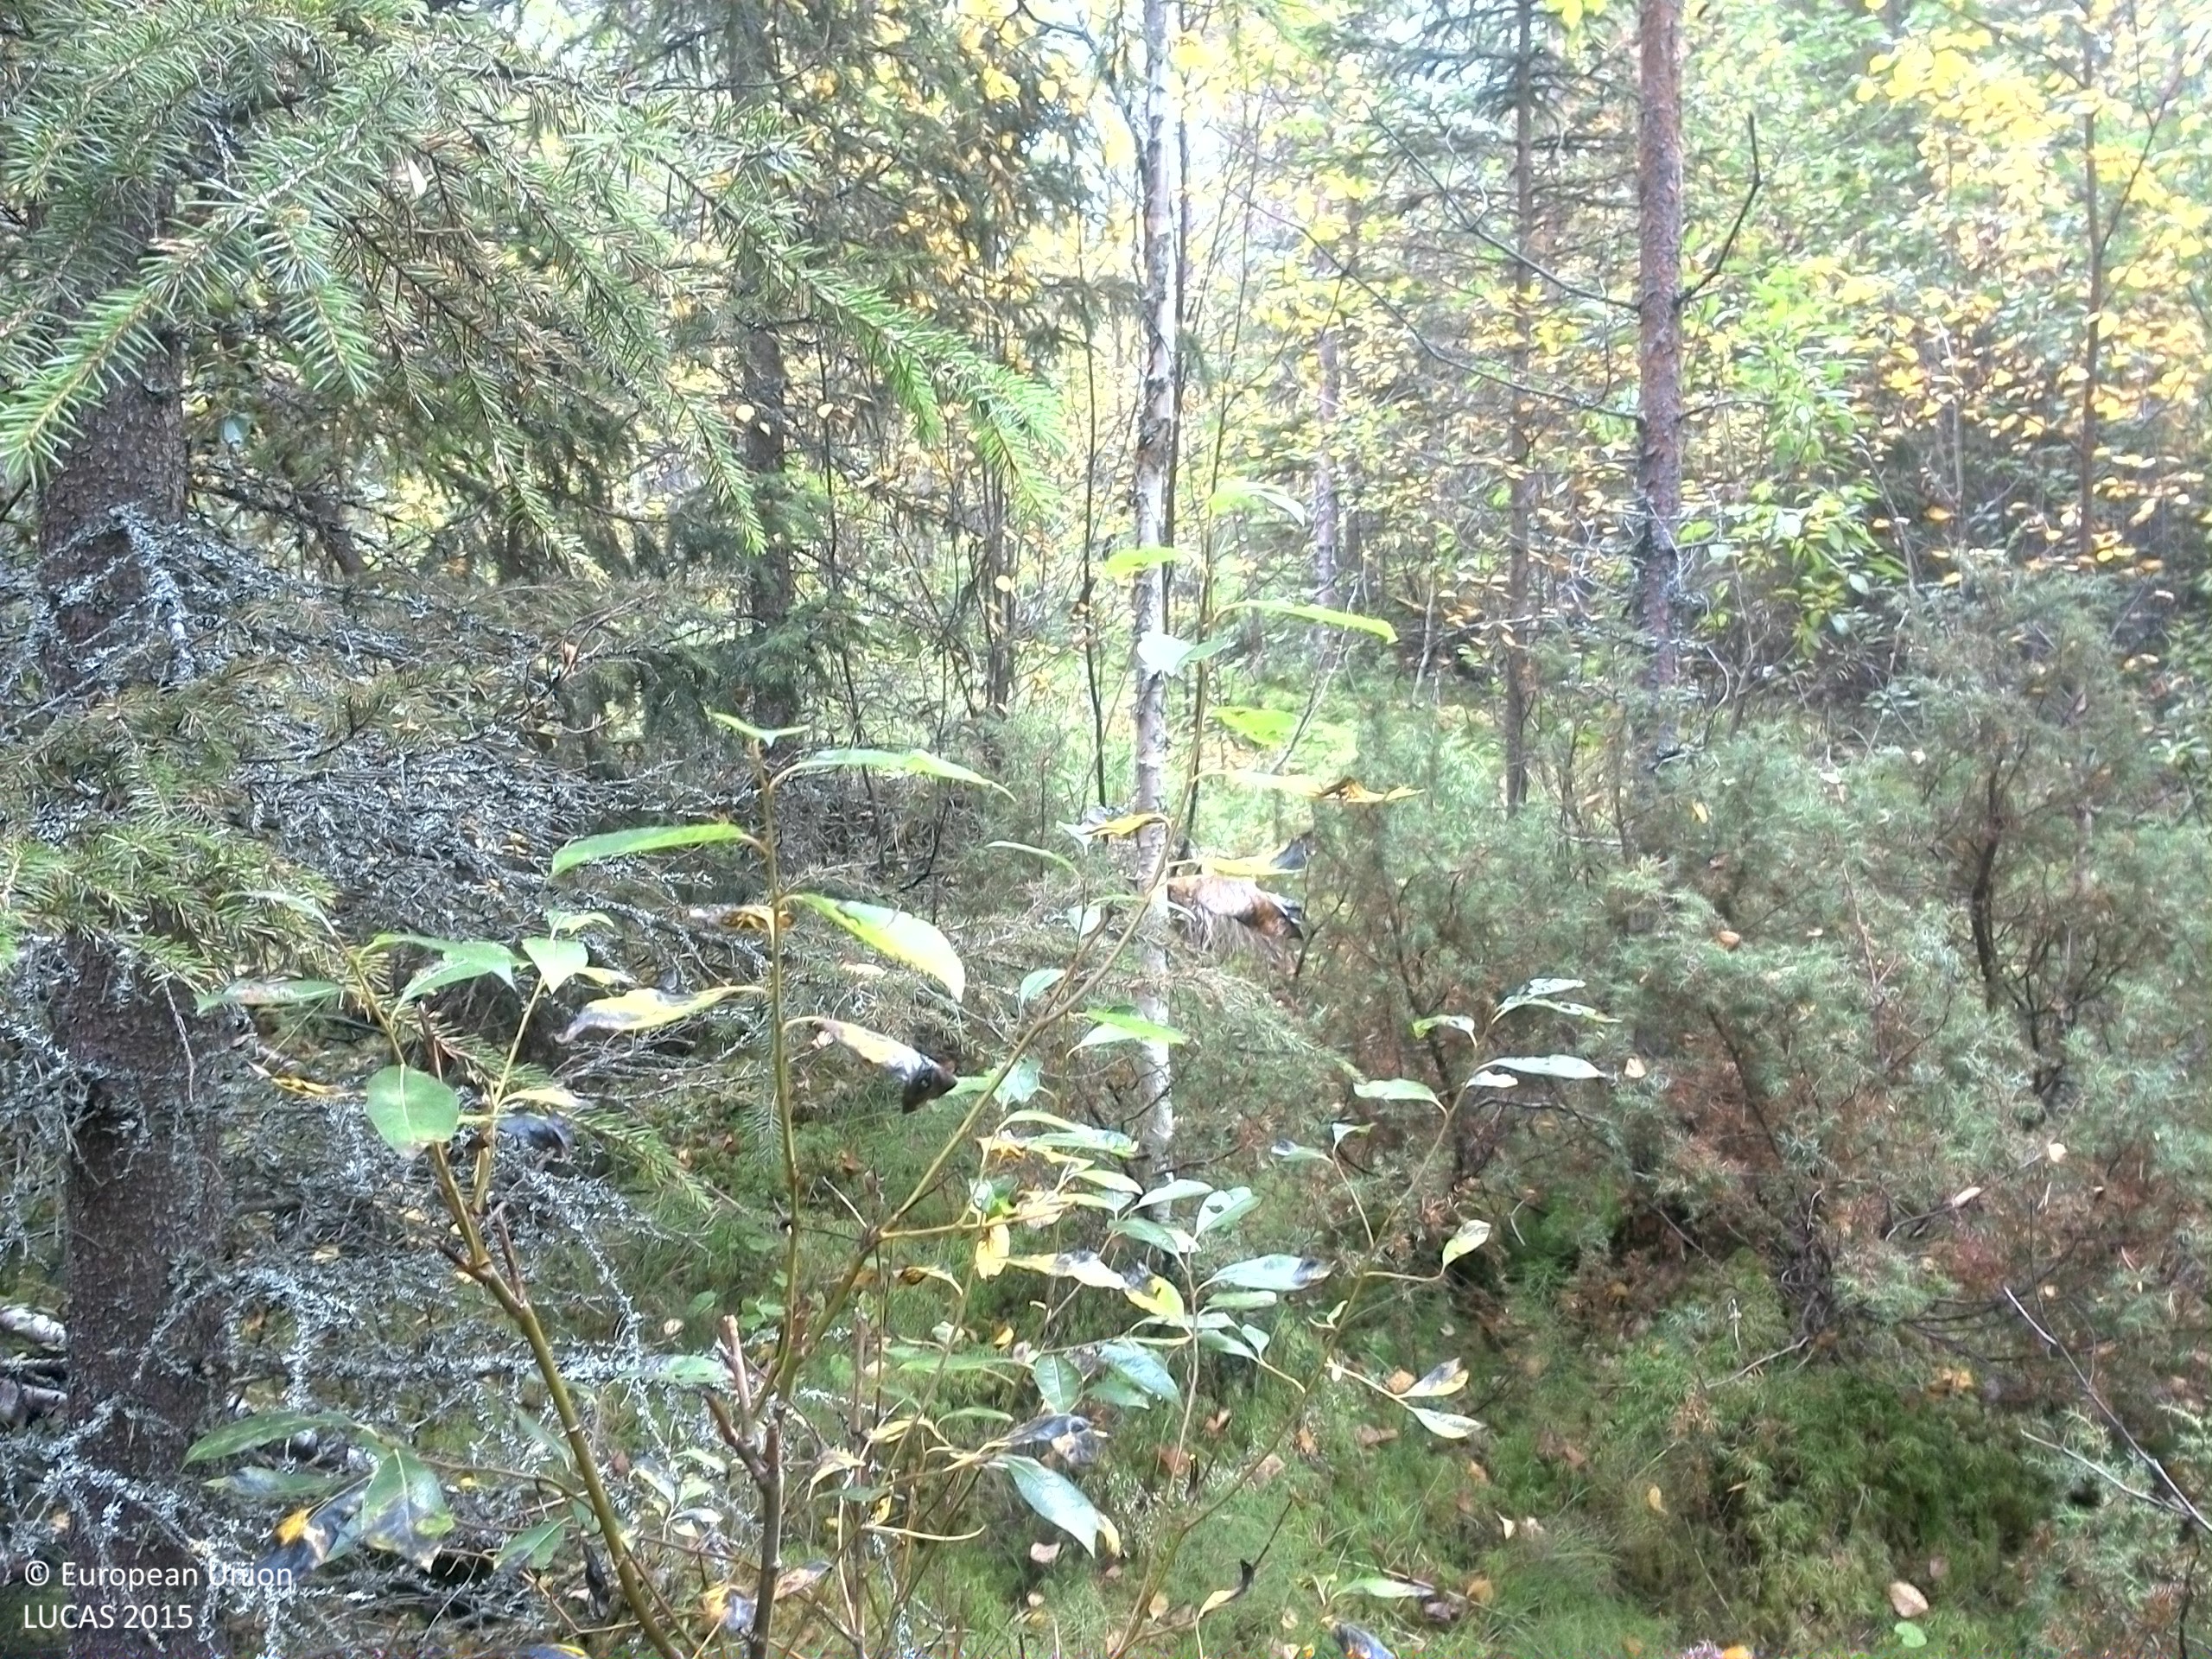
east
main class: Woodland
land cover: Spruce dominated mixed woodland
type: boreal forest
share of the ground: > 75 %
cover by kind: coniferous forest trees 45 %, broadleaved forest trees 30 %, shrubs 10 %, lichens and mosses 10 %, herbaceous plants 5 %
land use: Forestry
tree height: > 5 m
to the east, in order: Spruce dominated mixed woodland; Pine dominated mixed woodland; Pine dominated coniferous woodland; Pine dominated mixed woodland
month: September
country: SE
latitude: 63.7324
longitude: 16.2307
